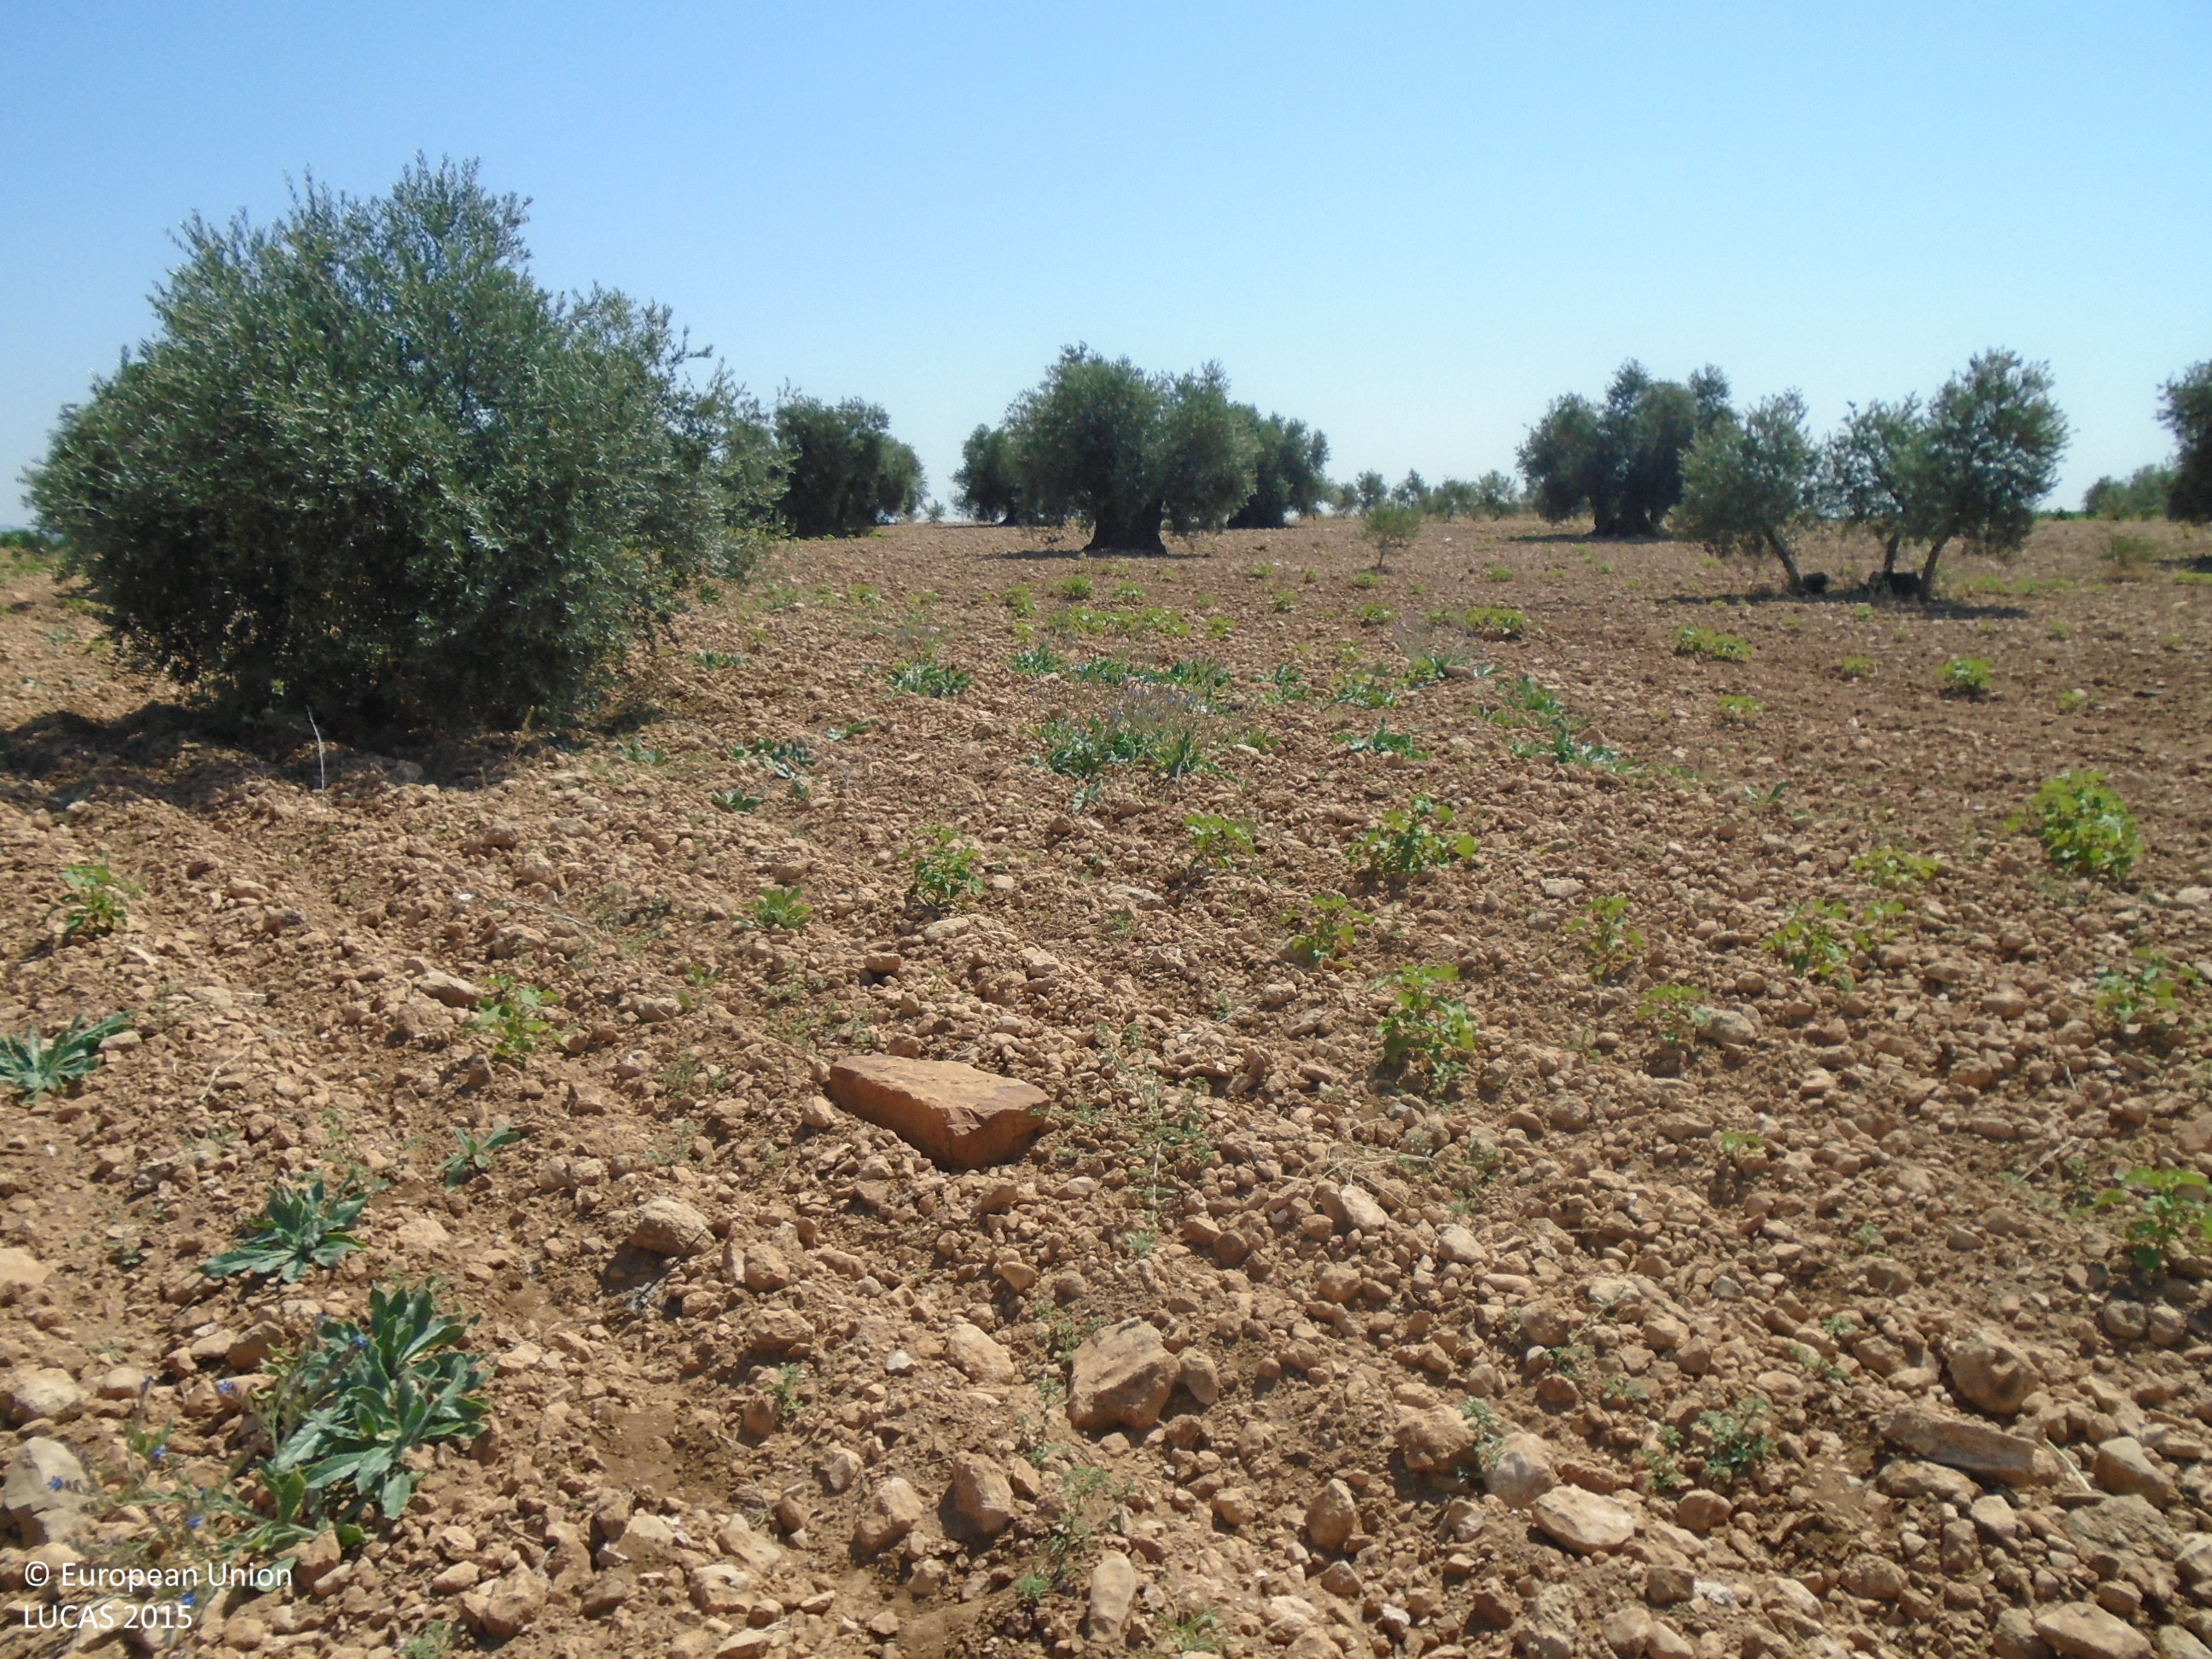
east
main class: Cropland
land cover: Olive groves
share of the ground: 10 - 25 %
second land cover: Other bare soil
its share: > 75 %
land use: Agriculture (excluding fallow land and kitchen gardens)
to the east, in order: Olive groves; Other bare soil; Grass margins; Olive groves; Dry stone walls; Other bare soil; Grass margins; Paved roads, cycling and walking lanes; Grass margins; Vineyards
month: June
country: ES
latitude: 39.1630
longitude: -3.6414
